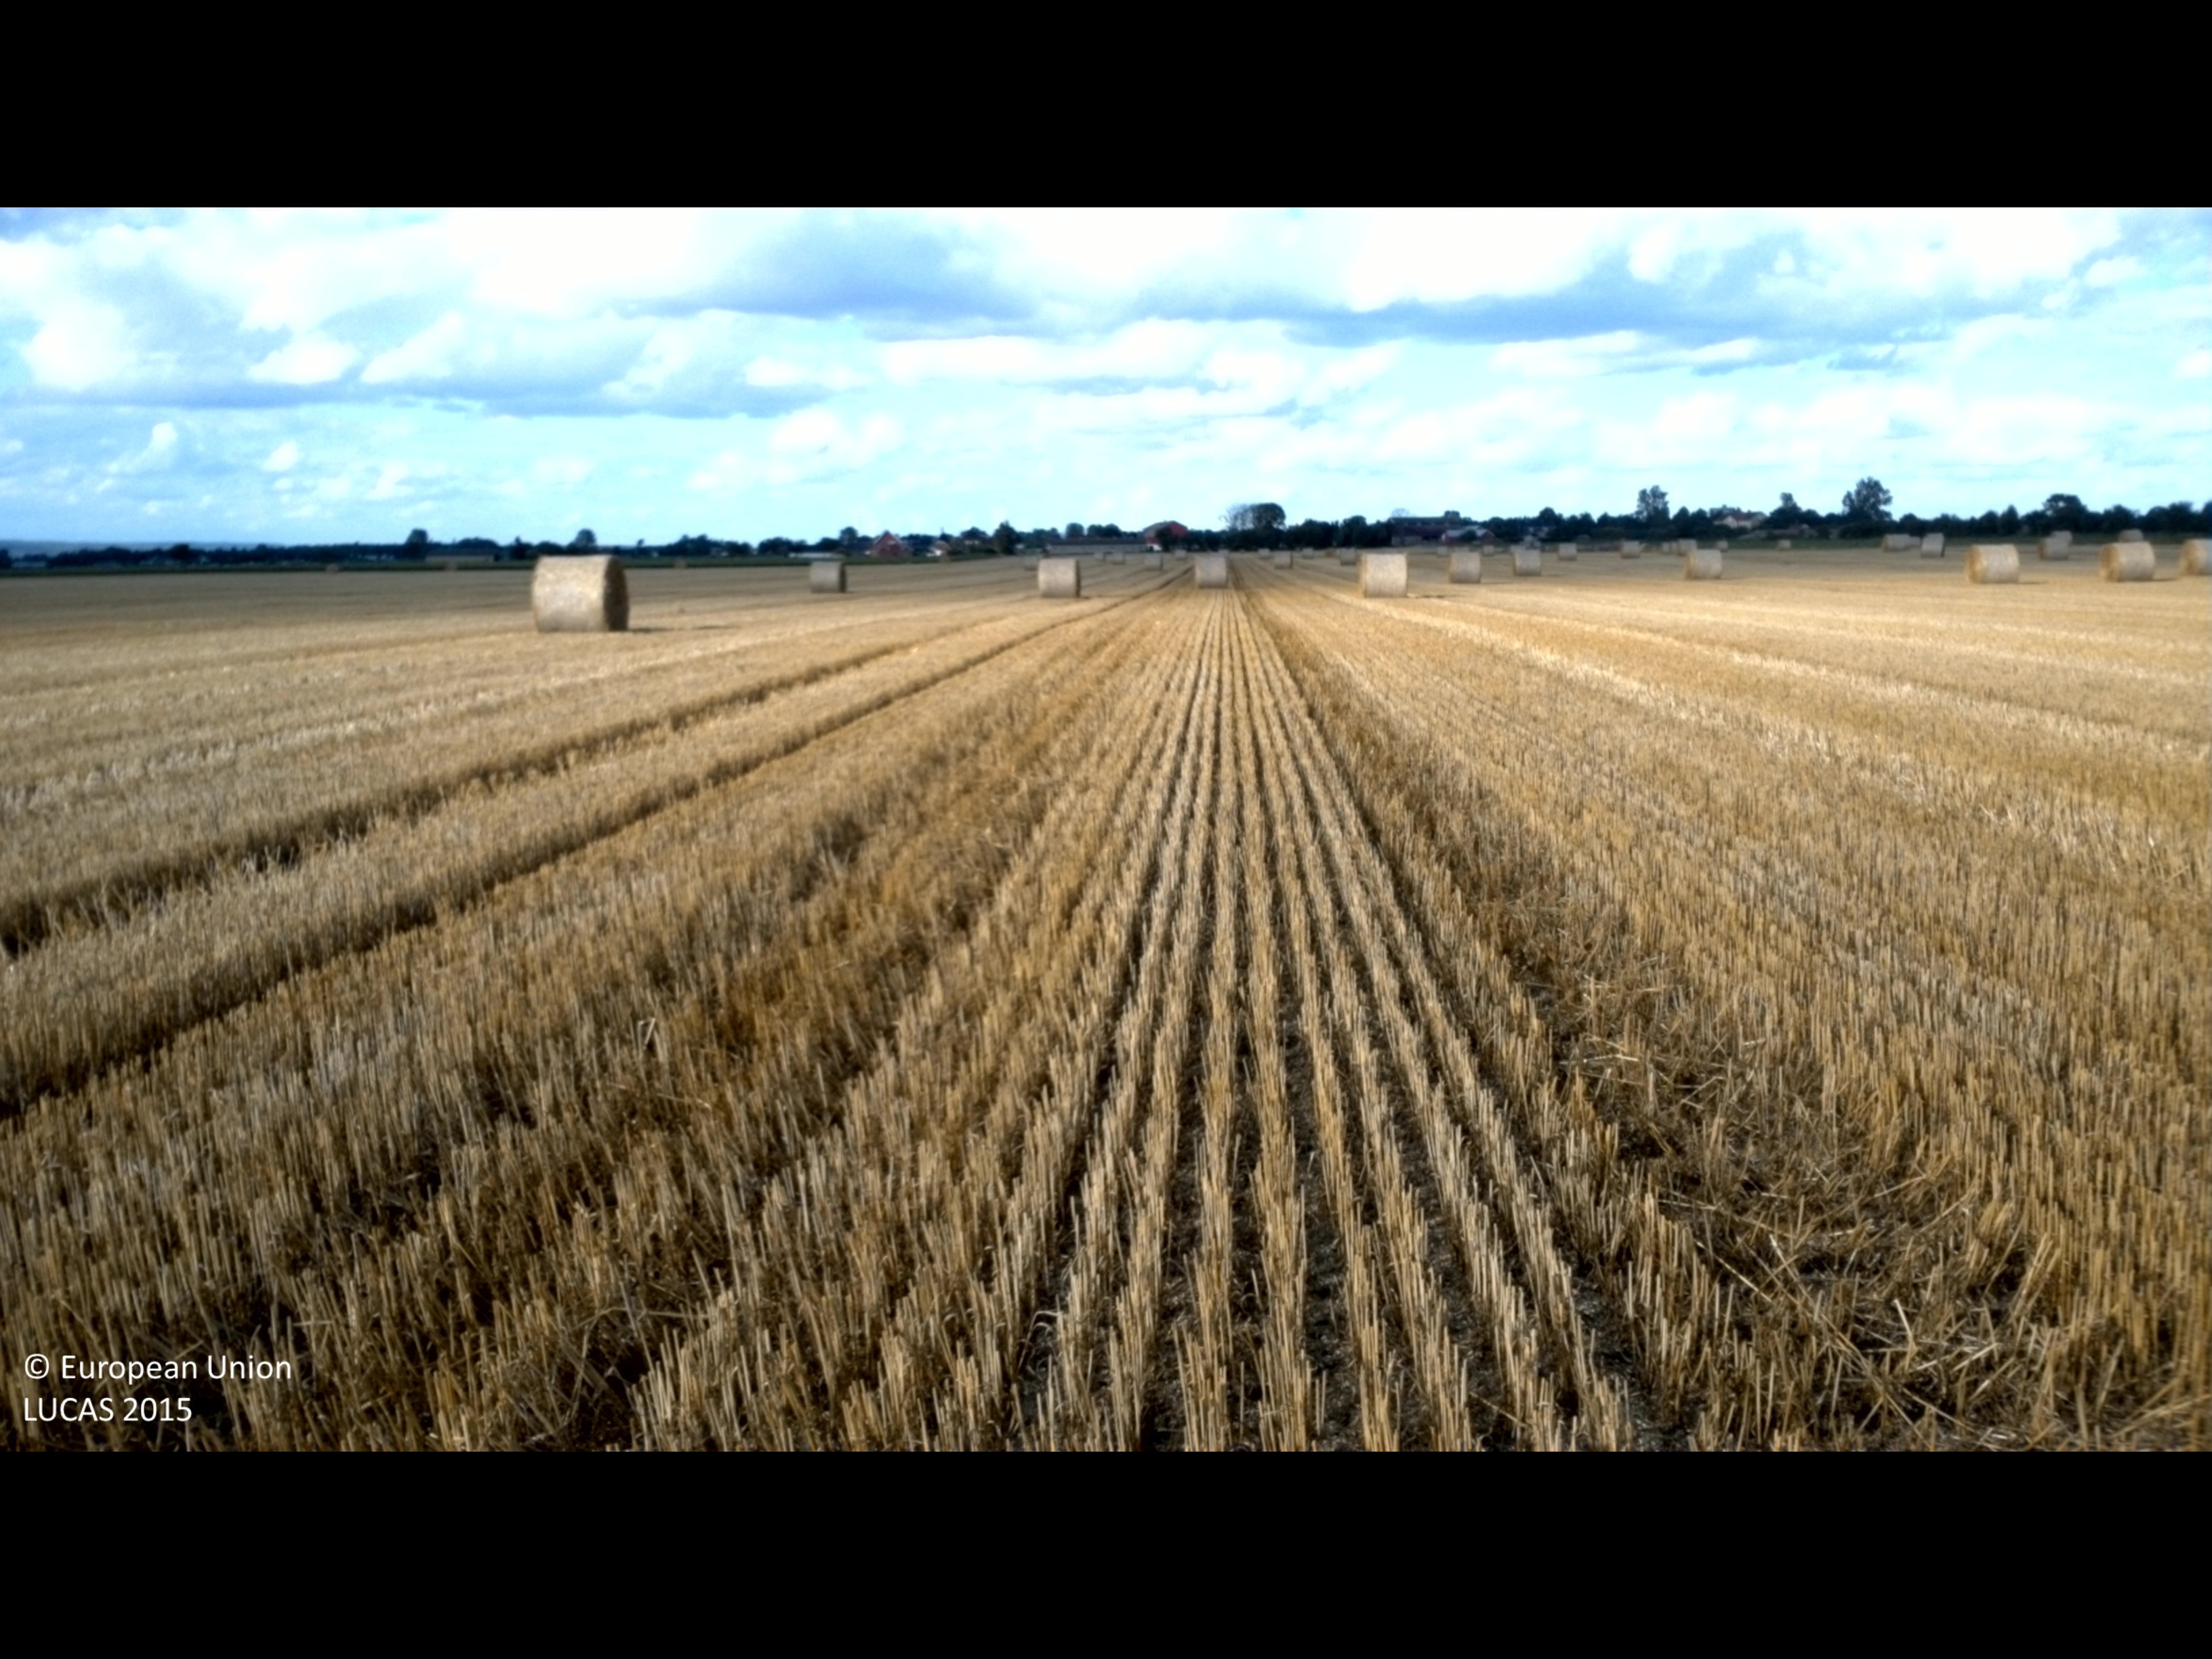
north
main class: Cropland
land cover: Common wheat
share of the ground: > 75 %
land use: Agriculture (excluding fallow land and kitchen gardens)
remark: Harvested field
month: September
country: SE
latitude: 56.0309
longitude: 14.6683
